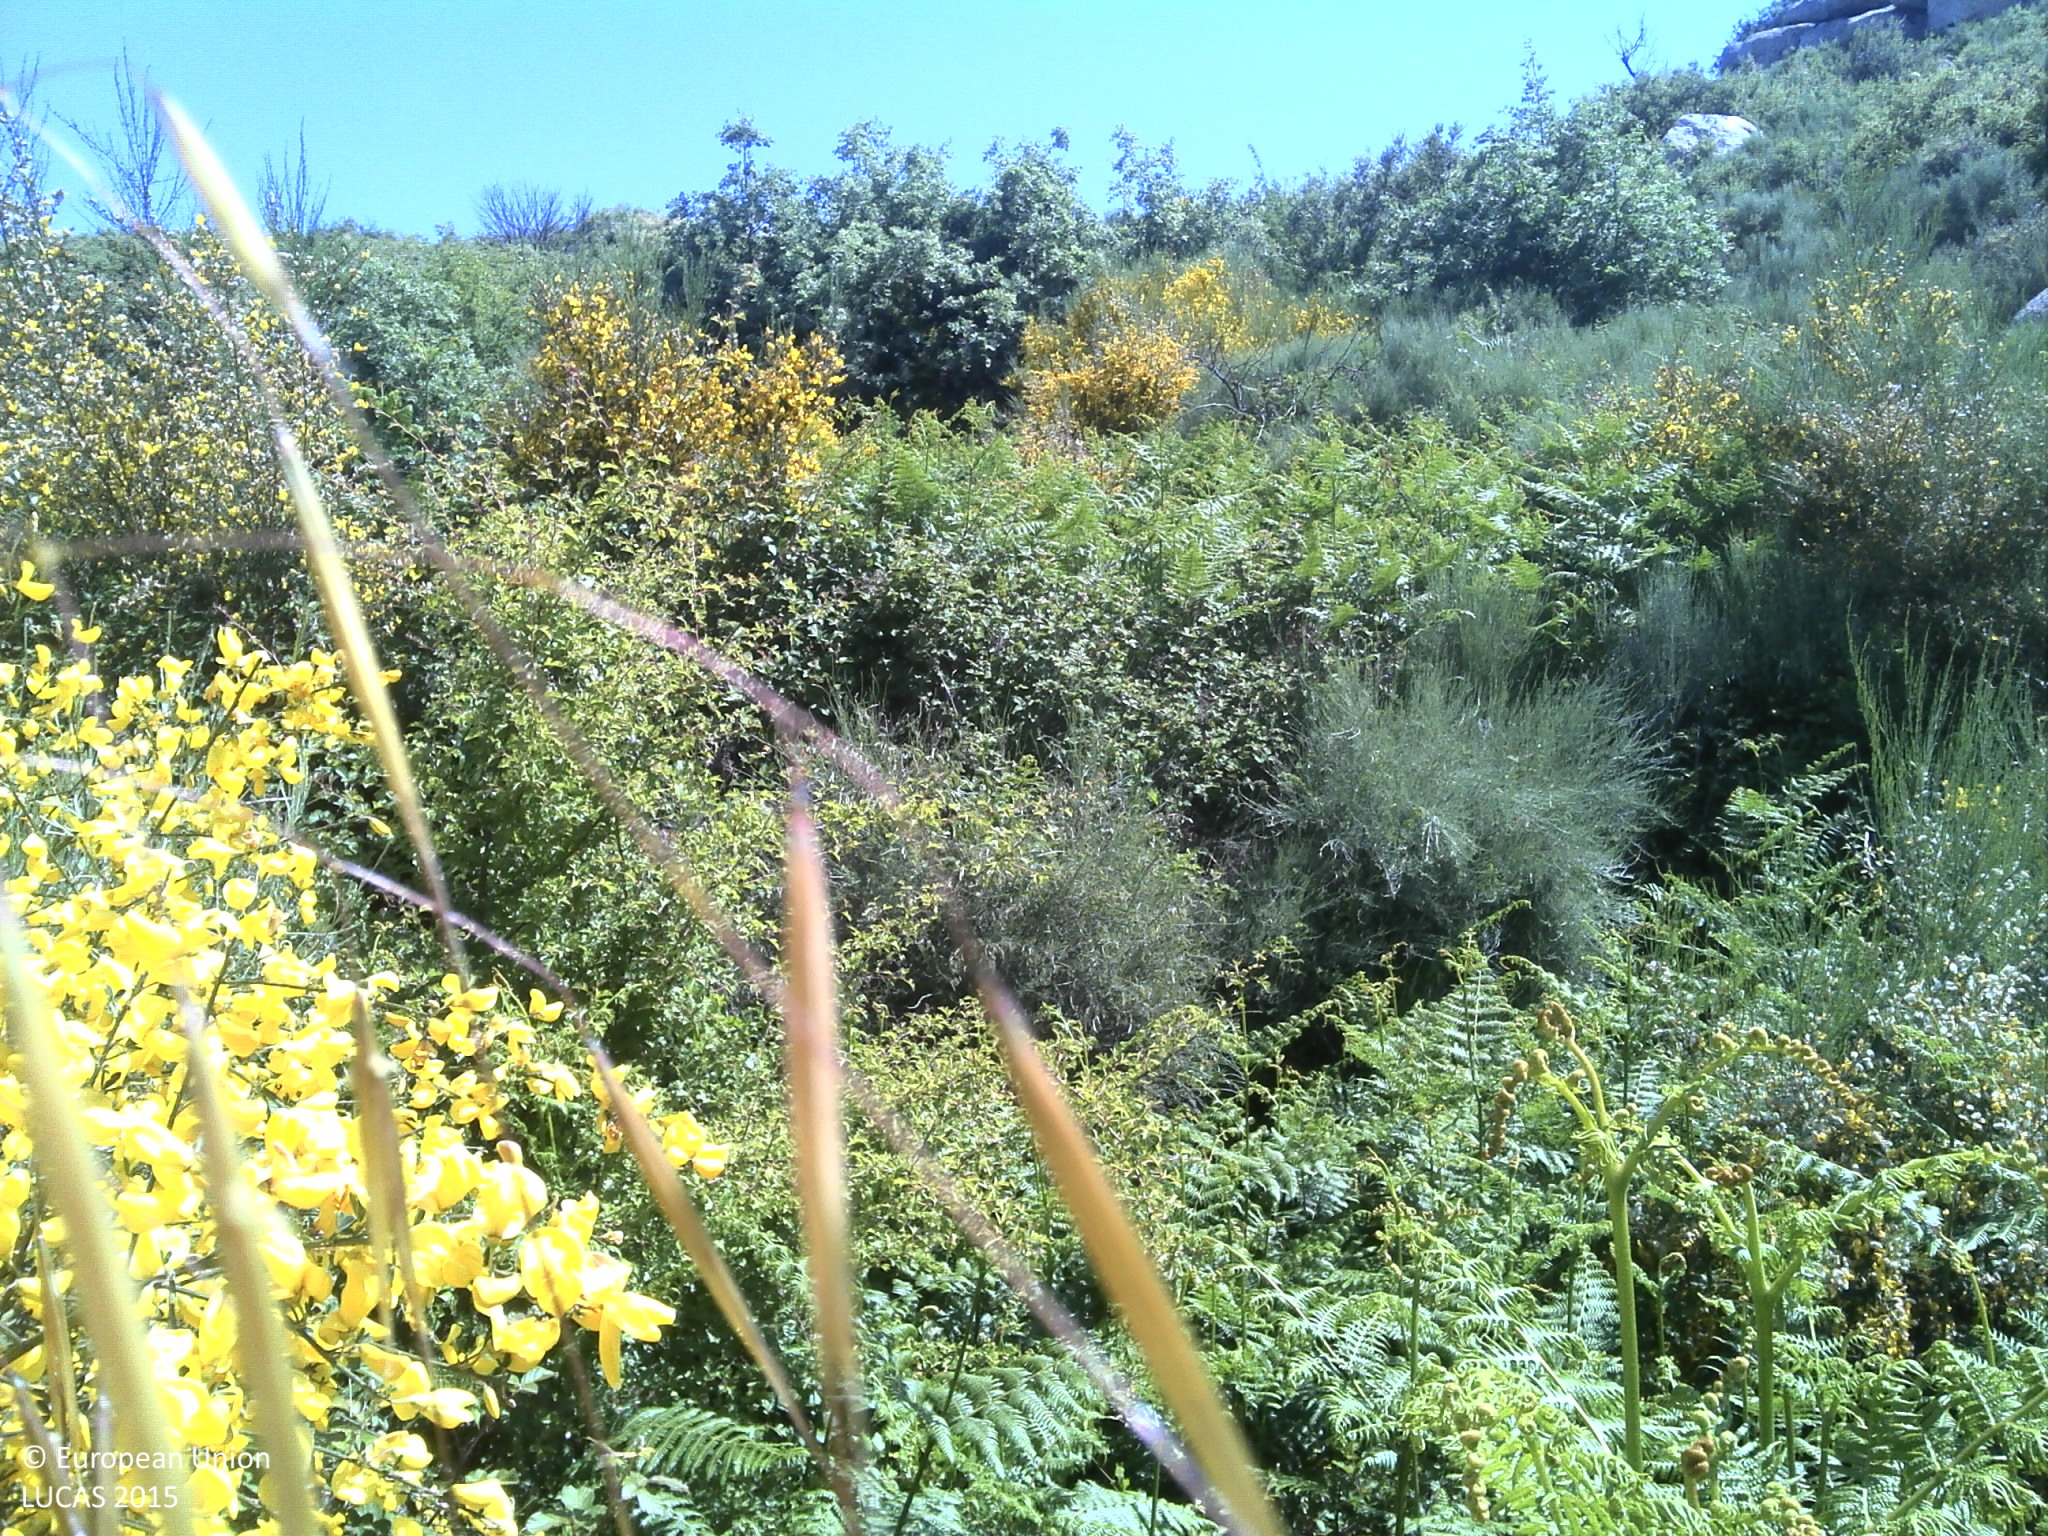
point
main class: Shrubland
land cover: Shrubland with sparse tree cover
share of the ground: > 75 %
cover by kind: shrubs 80 %, herbaceous plants 10 %, broadleaved forest trees 5 %
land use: Semi-natural and natural areas not in use
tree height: < 5 m
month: May
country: PT
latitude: 40.6244
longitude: -7.2603
